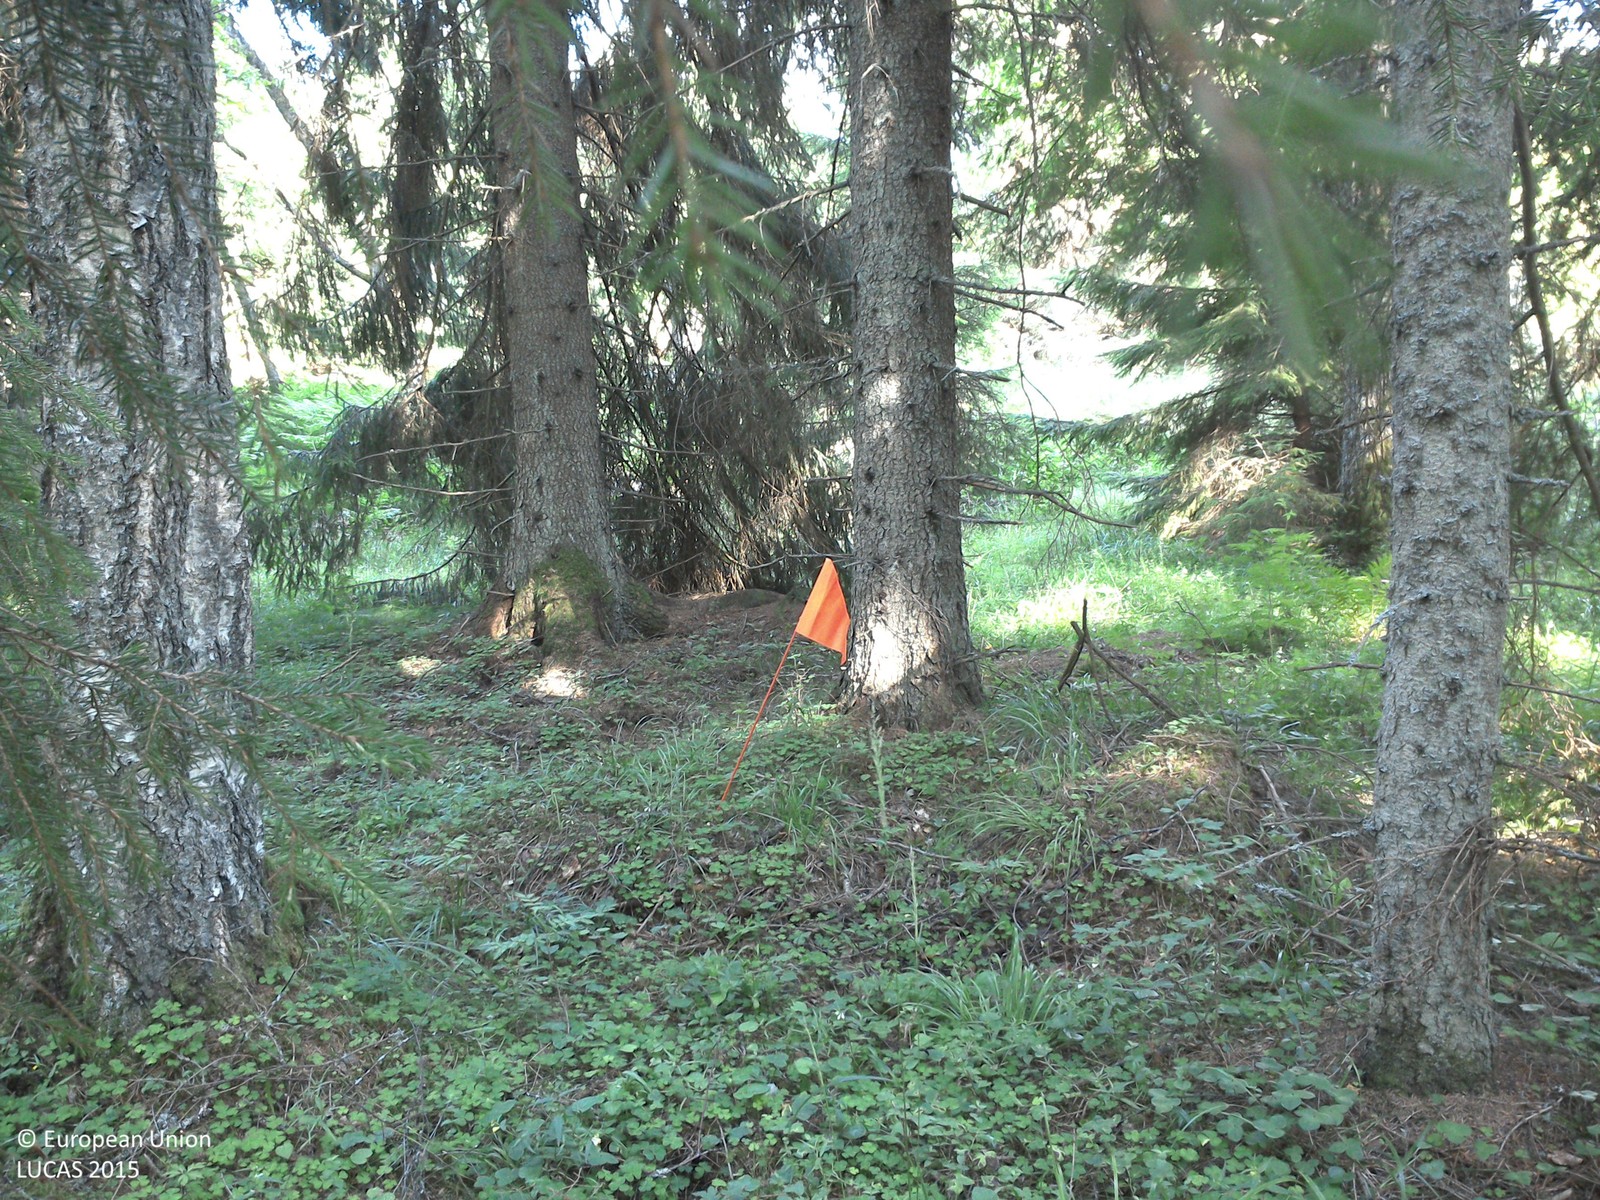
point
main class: Woodland
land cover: Spruce dominated coniferous woodland
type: boreal forest
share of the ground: > 75 %
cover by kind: coniferous forest trees 80 %, lichens and mosses 20 %
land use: Forestry
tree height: > 5 m
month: July
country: SE
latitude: 58.1565
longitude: 14.6676
